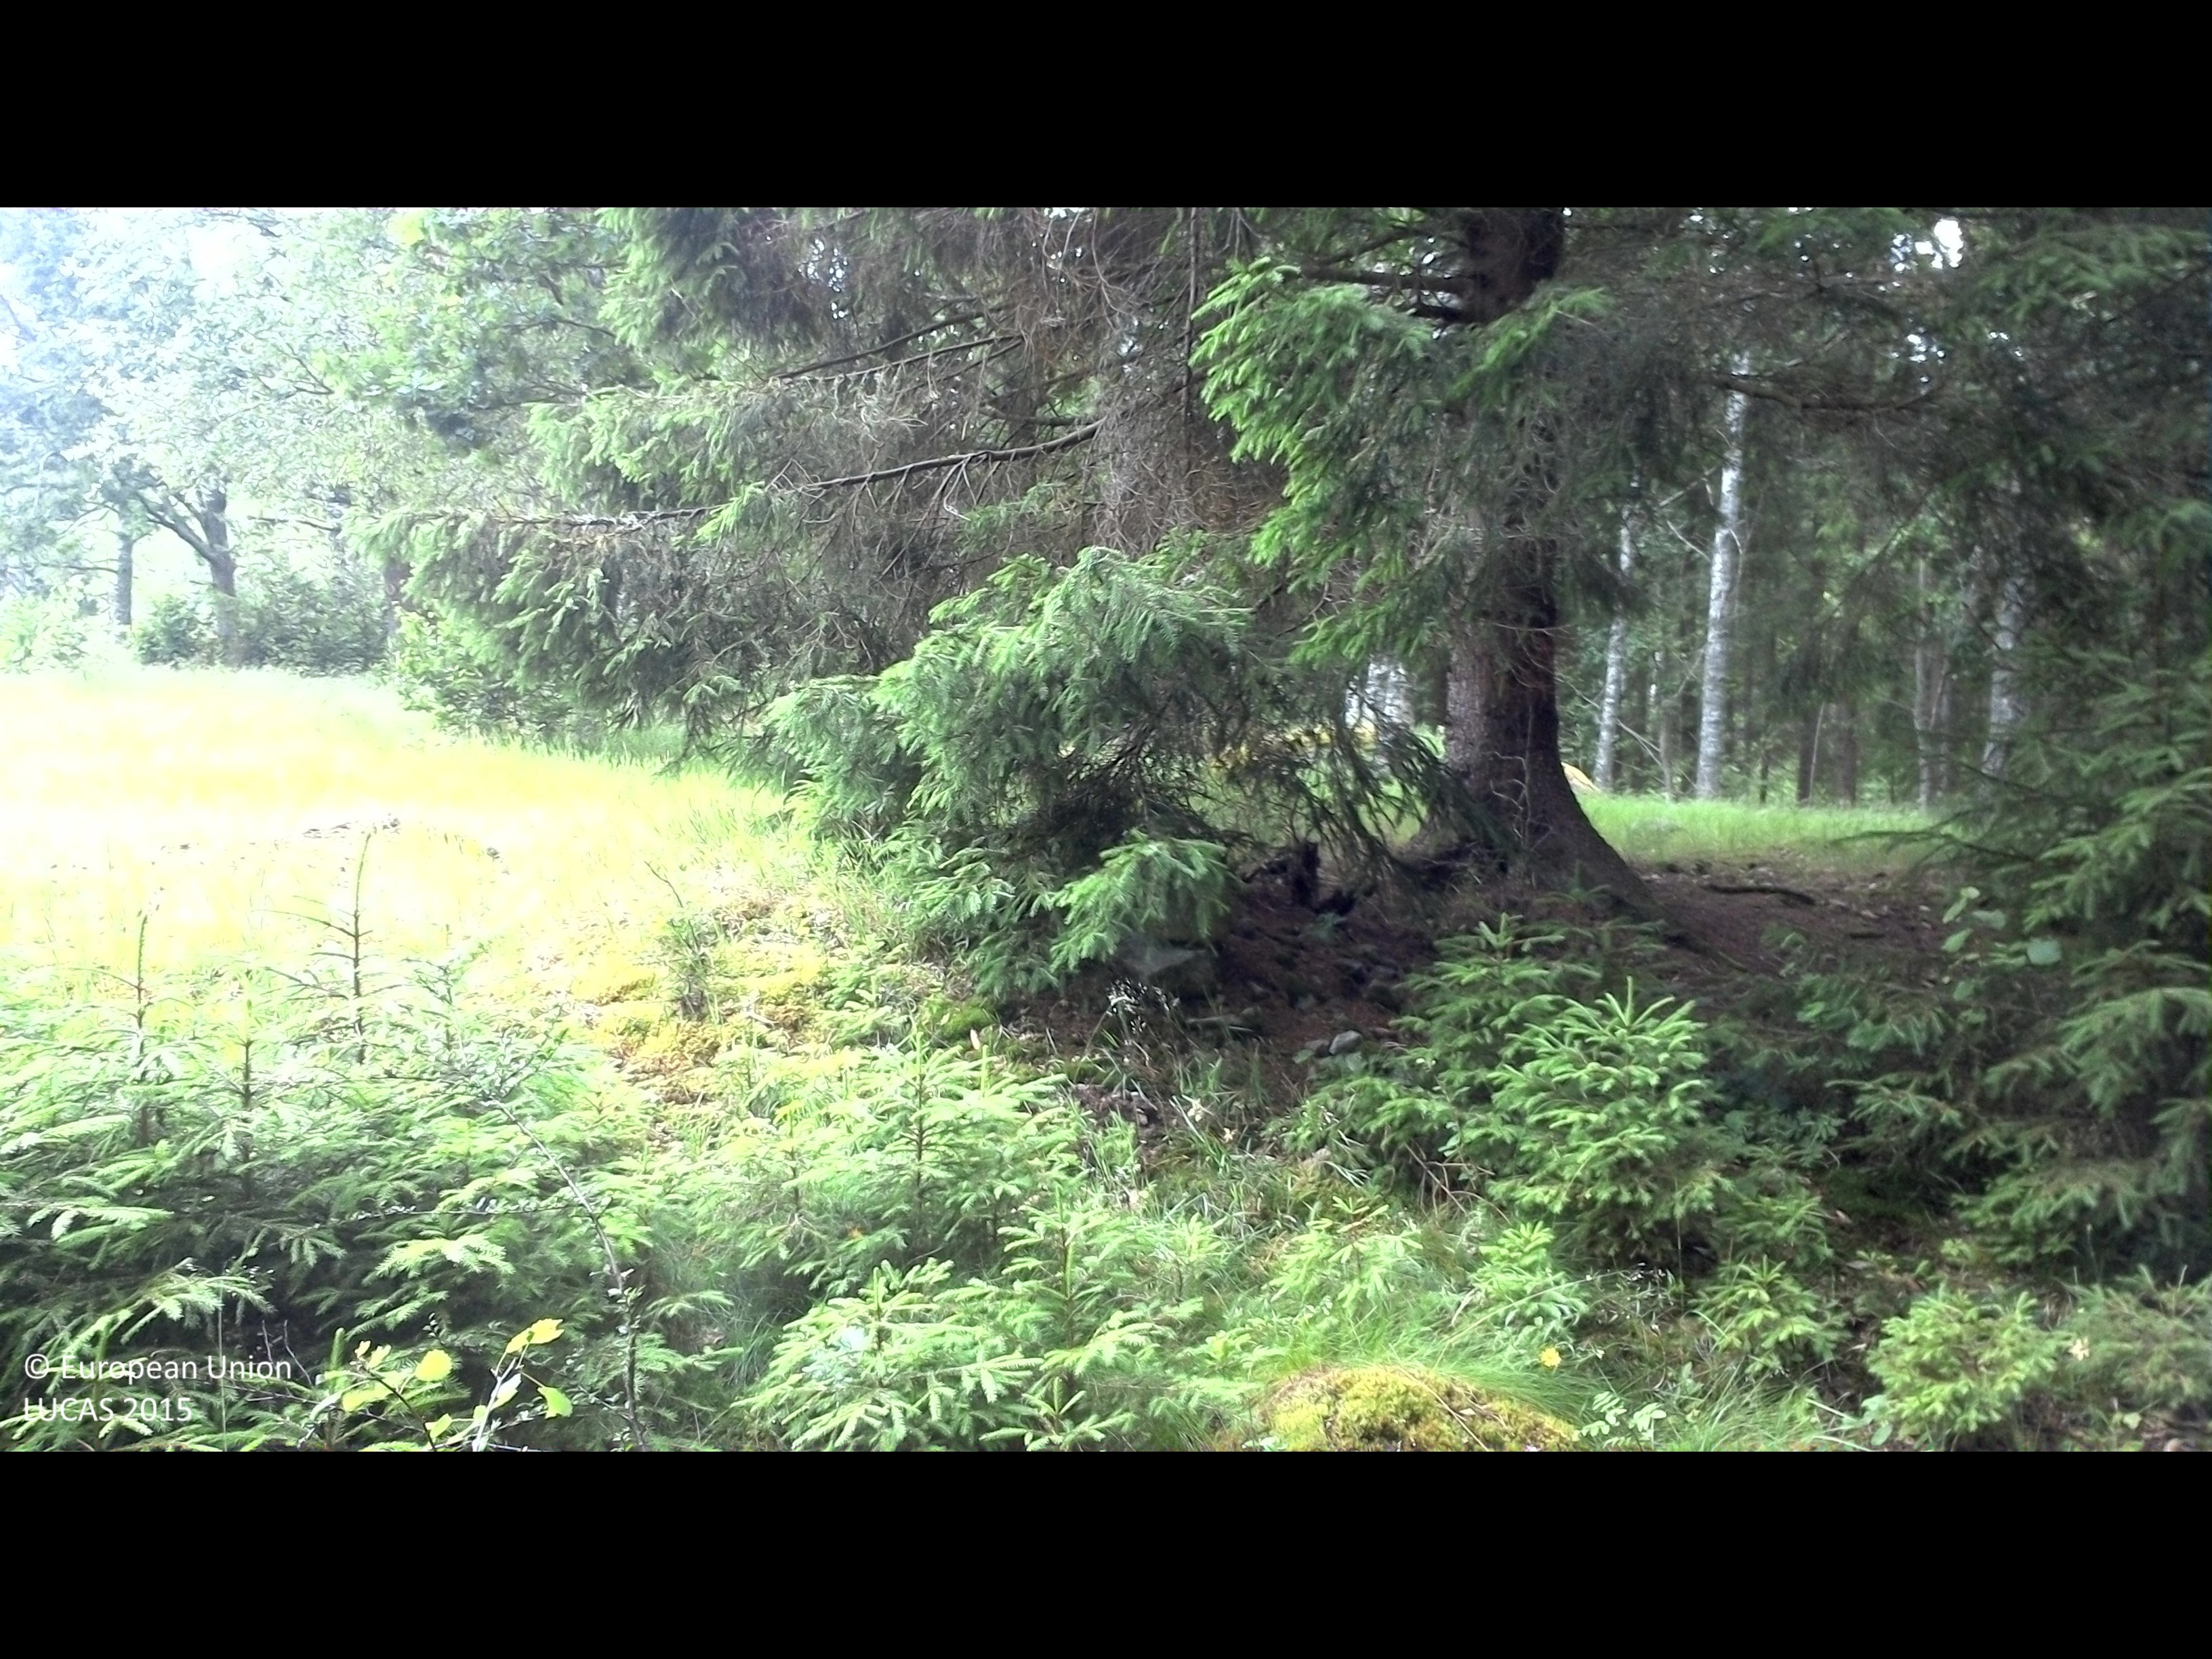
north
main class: Woodland
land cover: Spruce dominated mixed woodland
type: boreal forest
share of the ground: > 75 %
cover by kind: coniferous forest trees 55 %, broadleaved forest trees 20 %, shrubs 15 %, herbaceous plants 10 %
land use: Forestry
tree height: > 5 m
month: July
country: SE
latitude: 56.4600
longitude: 14.7527
